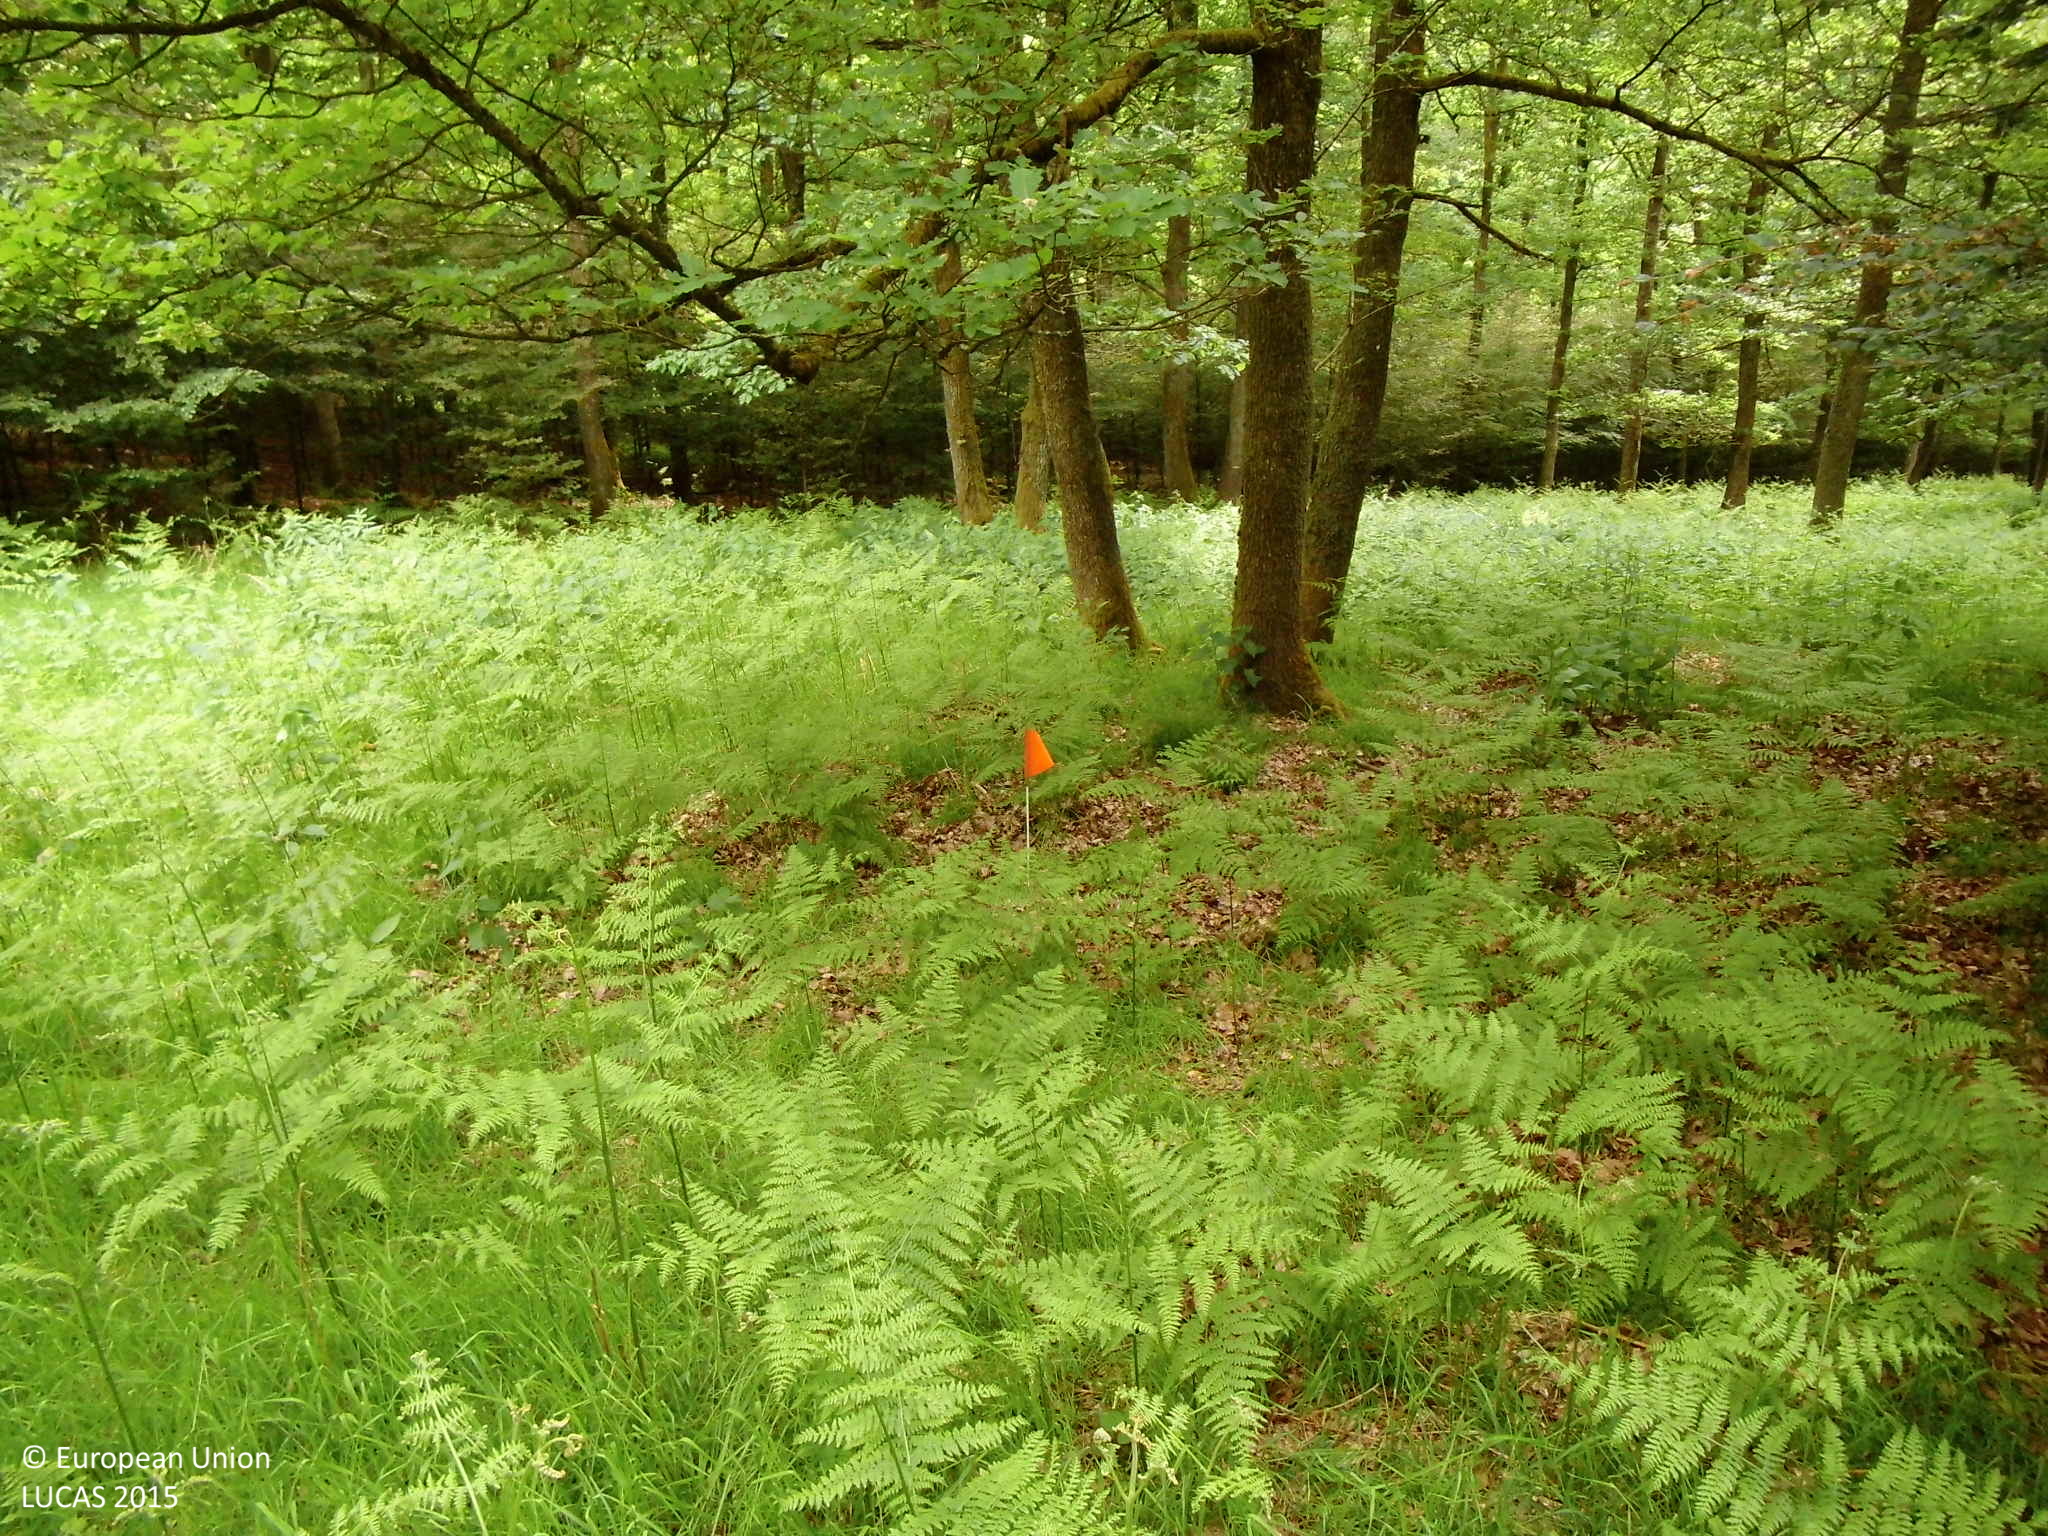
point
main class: Woodland
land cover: Broadleaved woodland
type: mesophytic deciduous forest
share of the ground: > 75 %
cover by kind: broadleaved forest trees 80 %, herbaceous plants 20 %
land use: Forestry
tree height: > 5 m
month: June
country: DE
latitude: 50.7981
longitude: 8.1133
